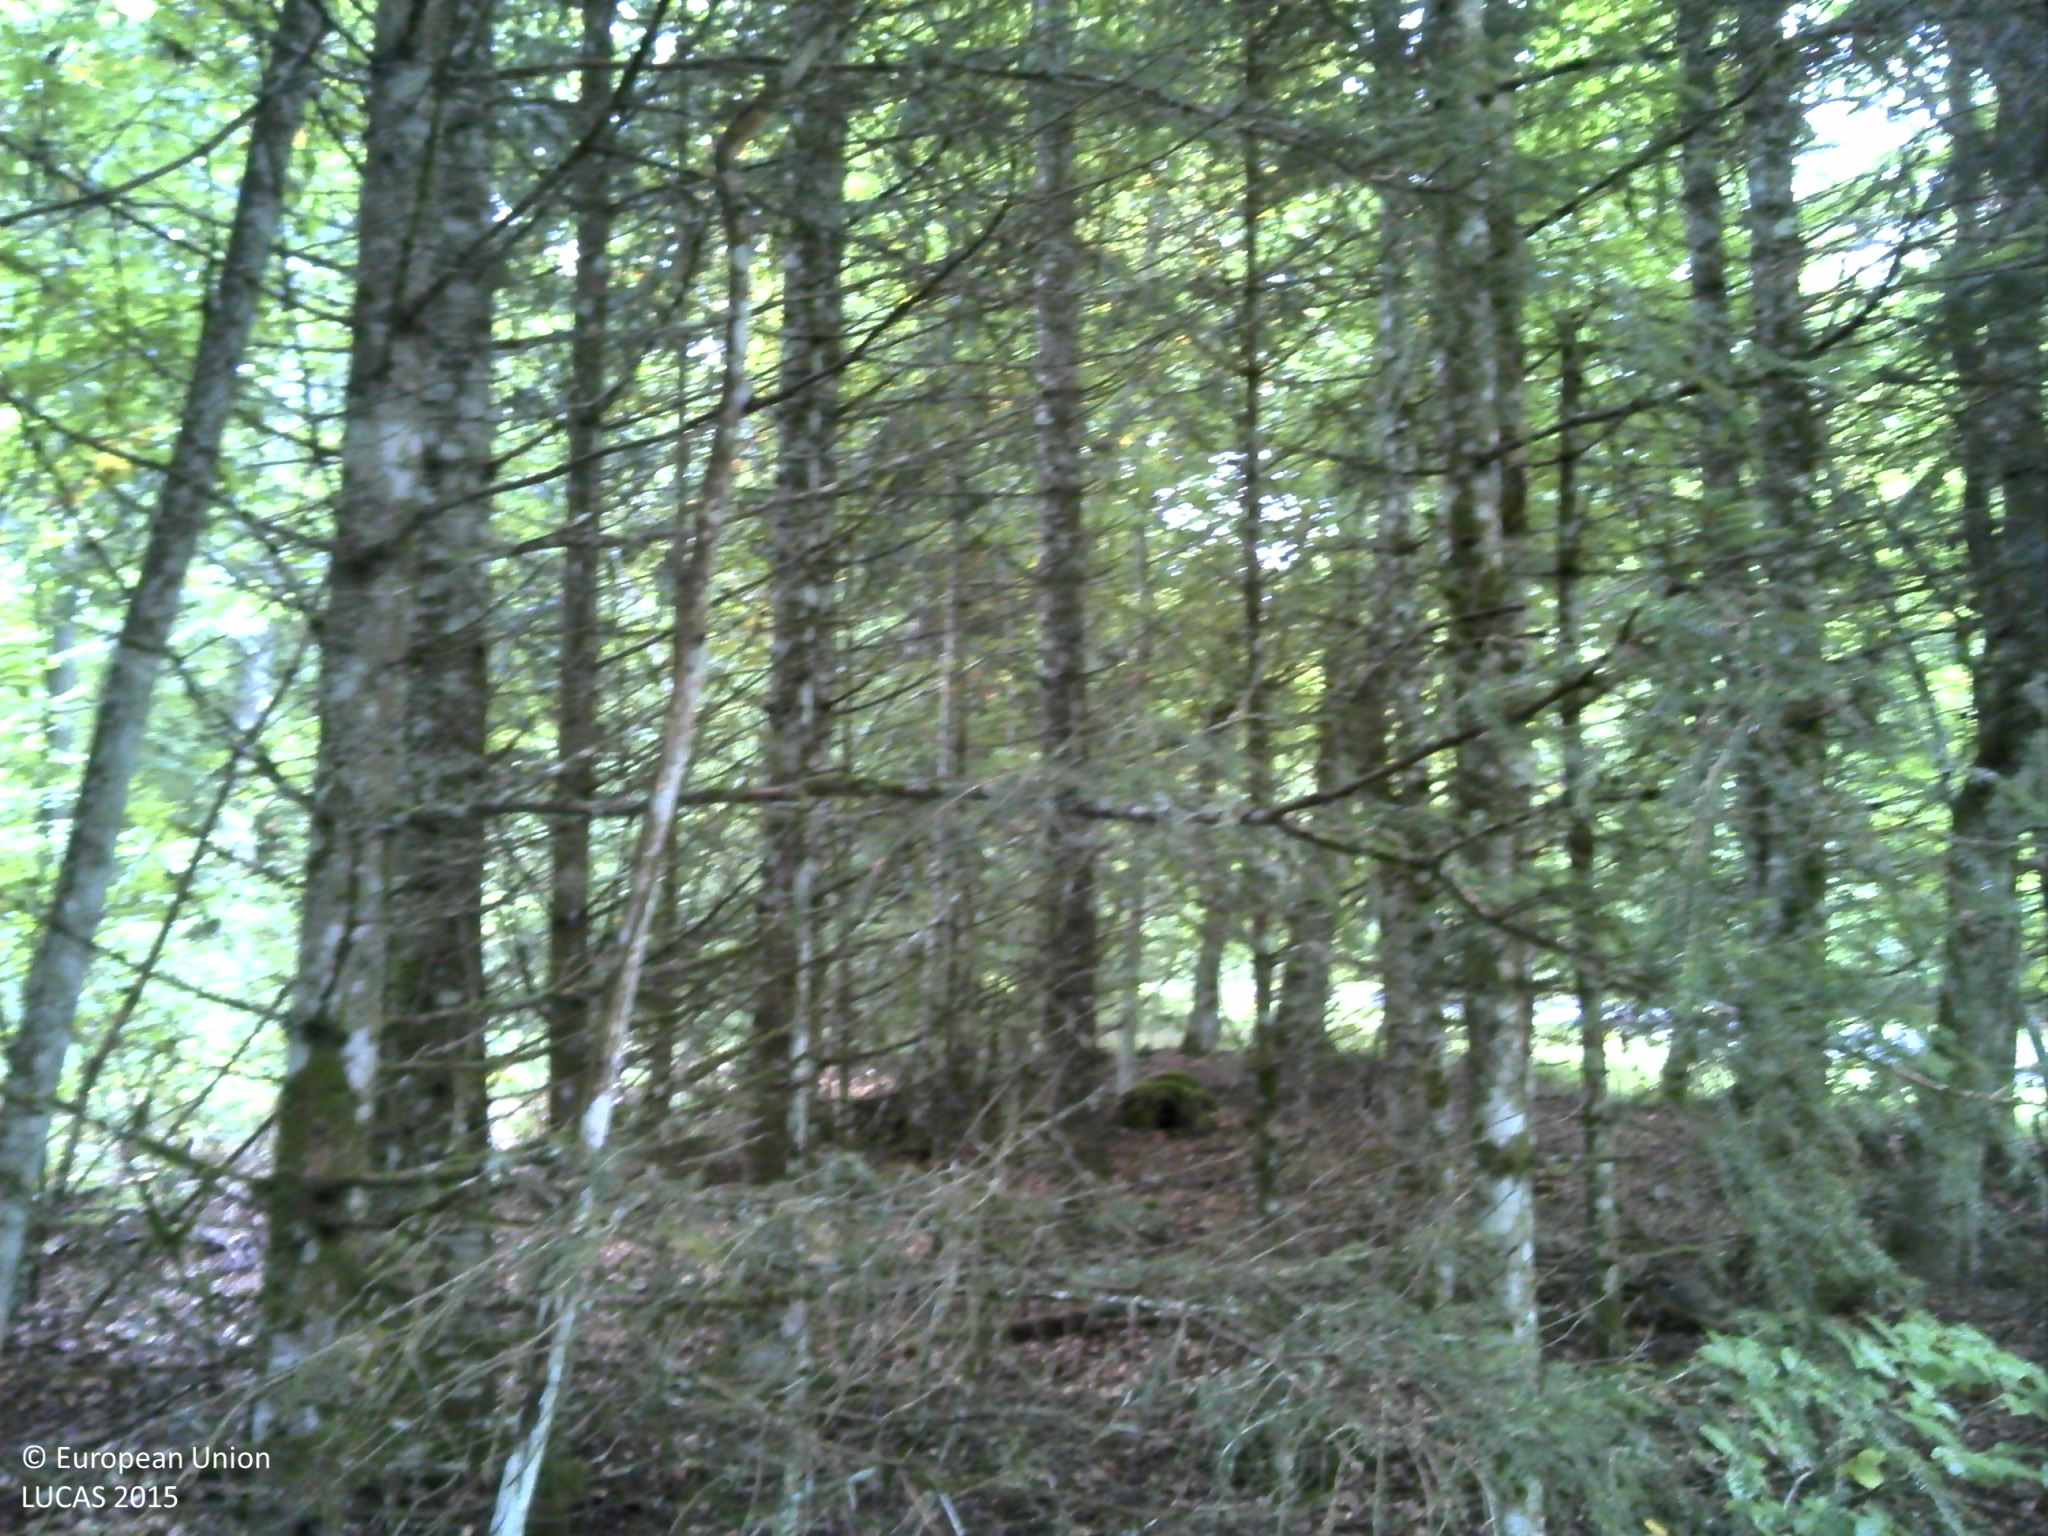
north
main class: Woodland
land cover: Spruce dominated mixed woodland
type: hemiboreal forest and nemoral coniferous forest and mixed broadleaved-coniferous forest
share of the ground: > 75 %
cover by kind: coniferous forest trees 60 %, broadleaved forest trees 30 %, lichens and mosses 10 %
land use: Forestry
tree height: > 5 m
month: September
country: FR
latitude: 45.5377
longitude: 2.9181
